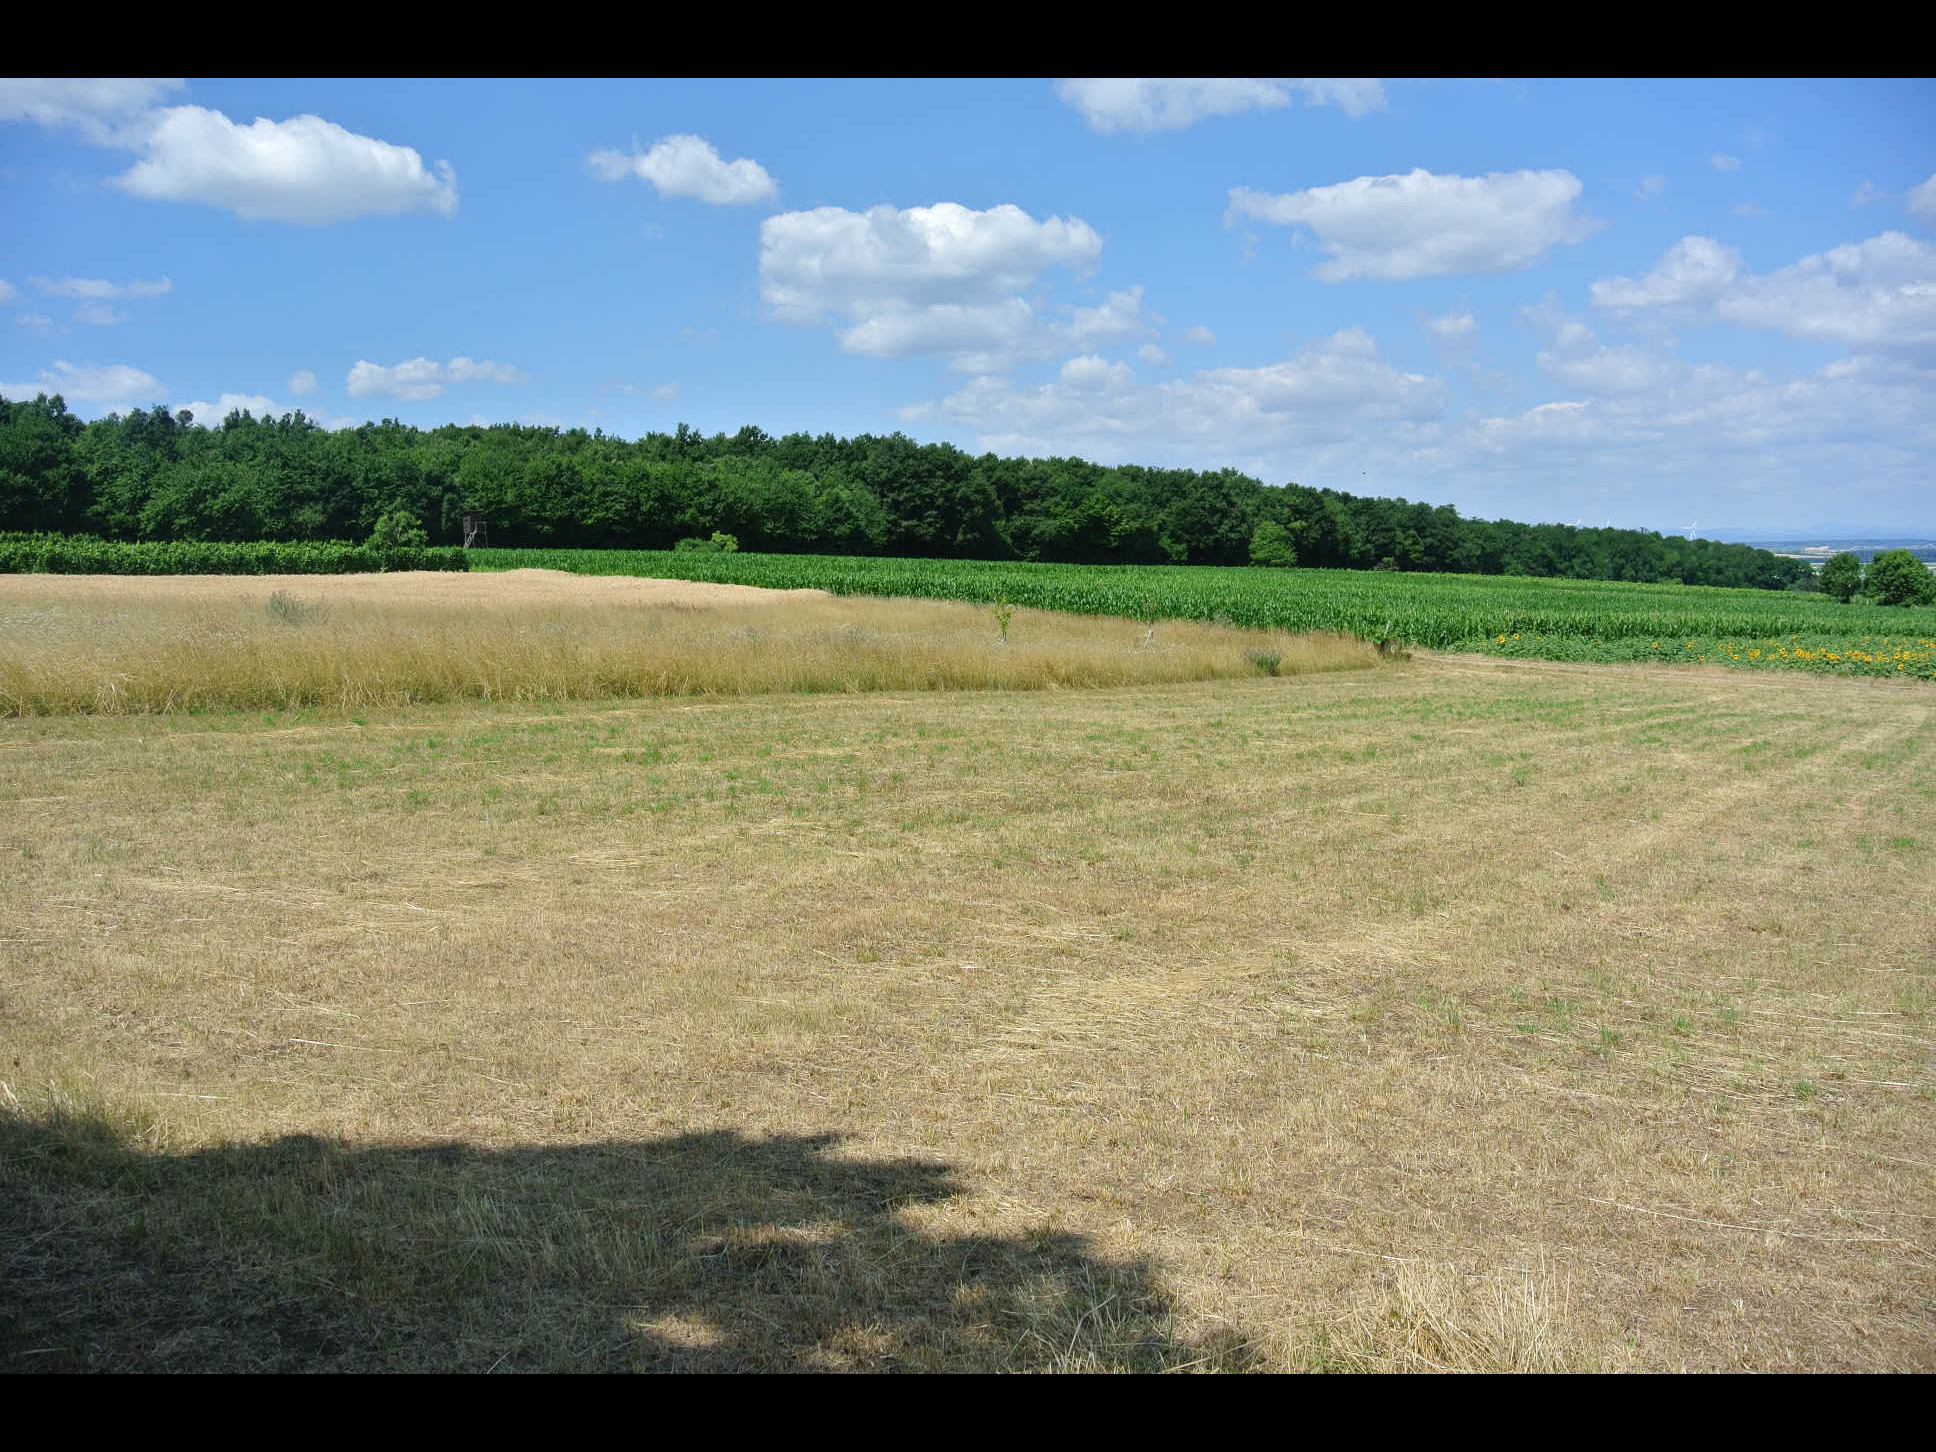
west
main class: Grassland
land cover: Grassland without tree/shrub cover
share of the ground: > 75 %
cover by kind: herbaceous plants 100 %
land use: Agriculture (excluding fallow land and kitchen gardens)
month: July
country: AT
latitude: 47.7444
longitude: 16.4728
